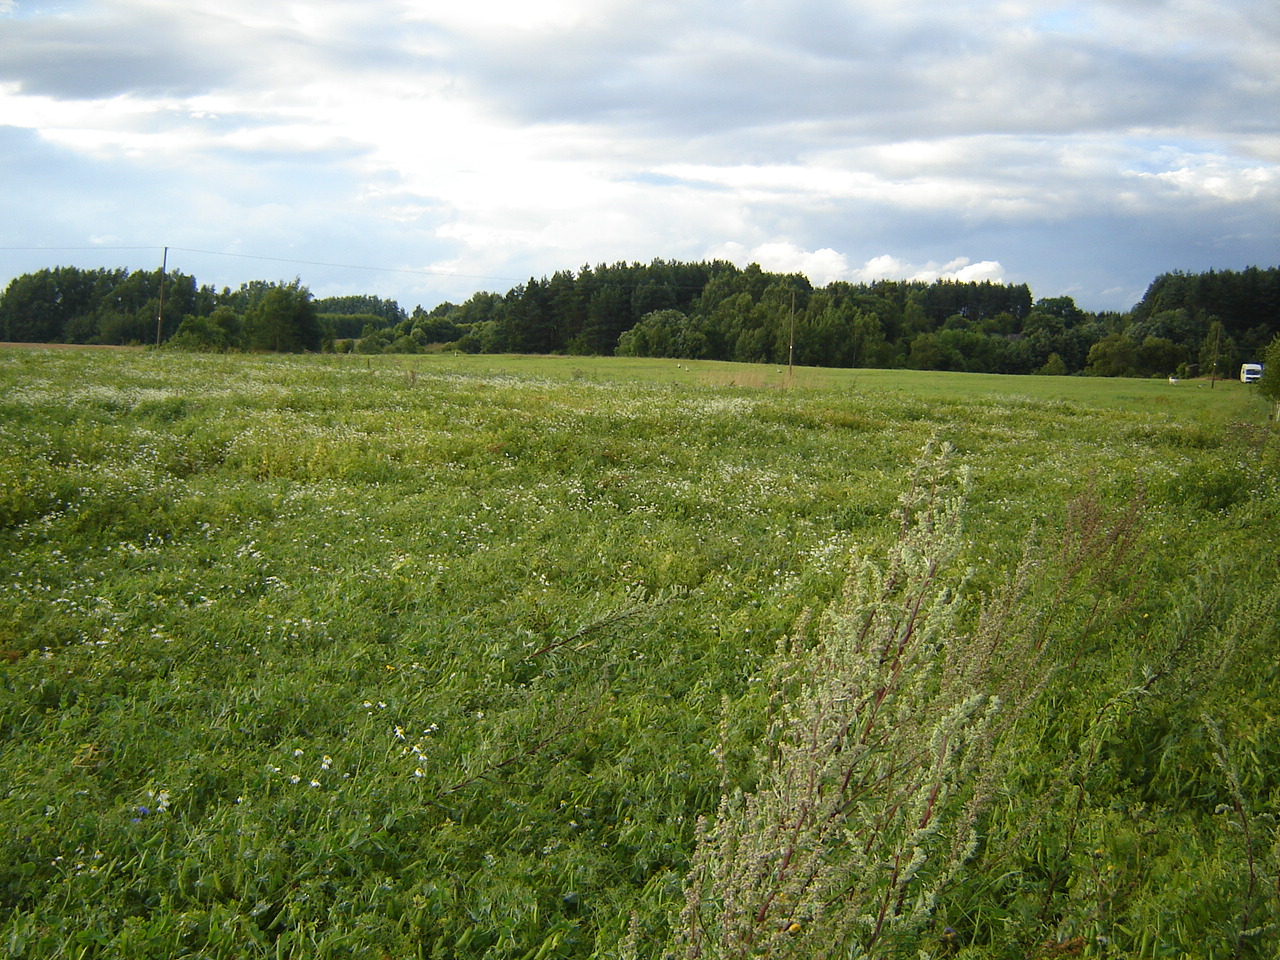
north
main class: Cropland
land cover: Dry pulses
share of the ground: > 75 %
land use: Agriculture (excluding fallow land and kitchen gardens)
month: July
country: LT
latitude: 55.2428
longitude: 25.0075
